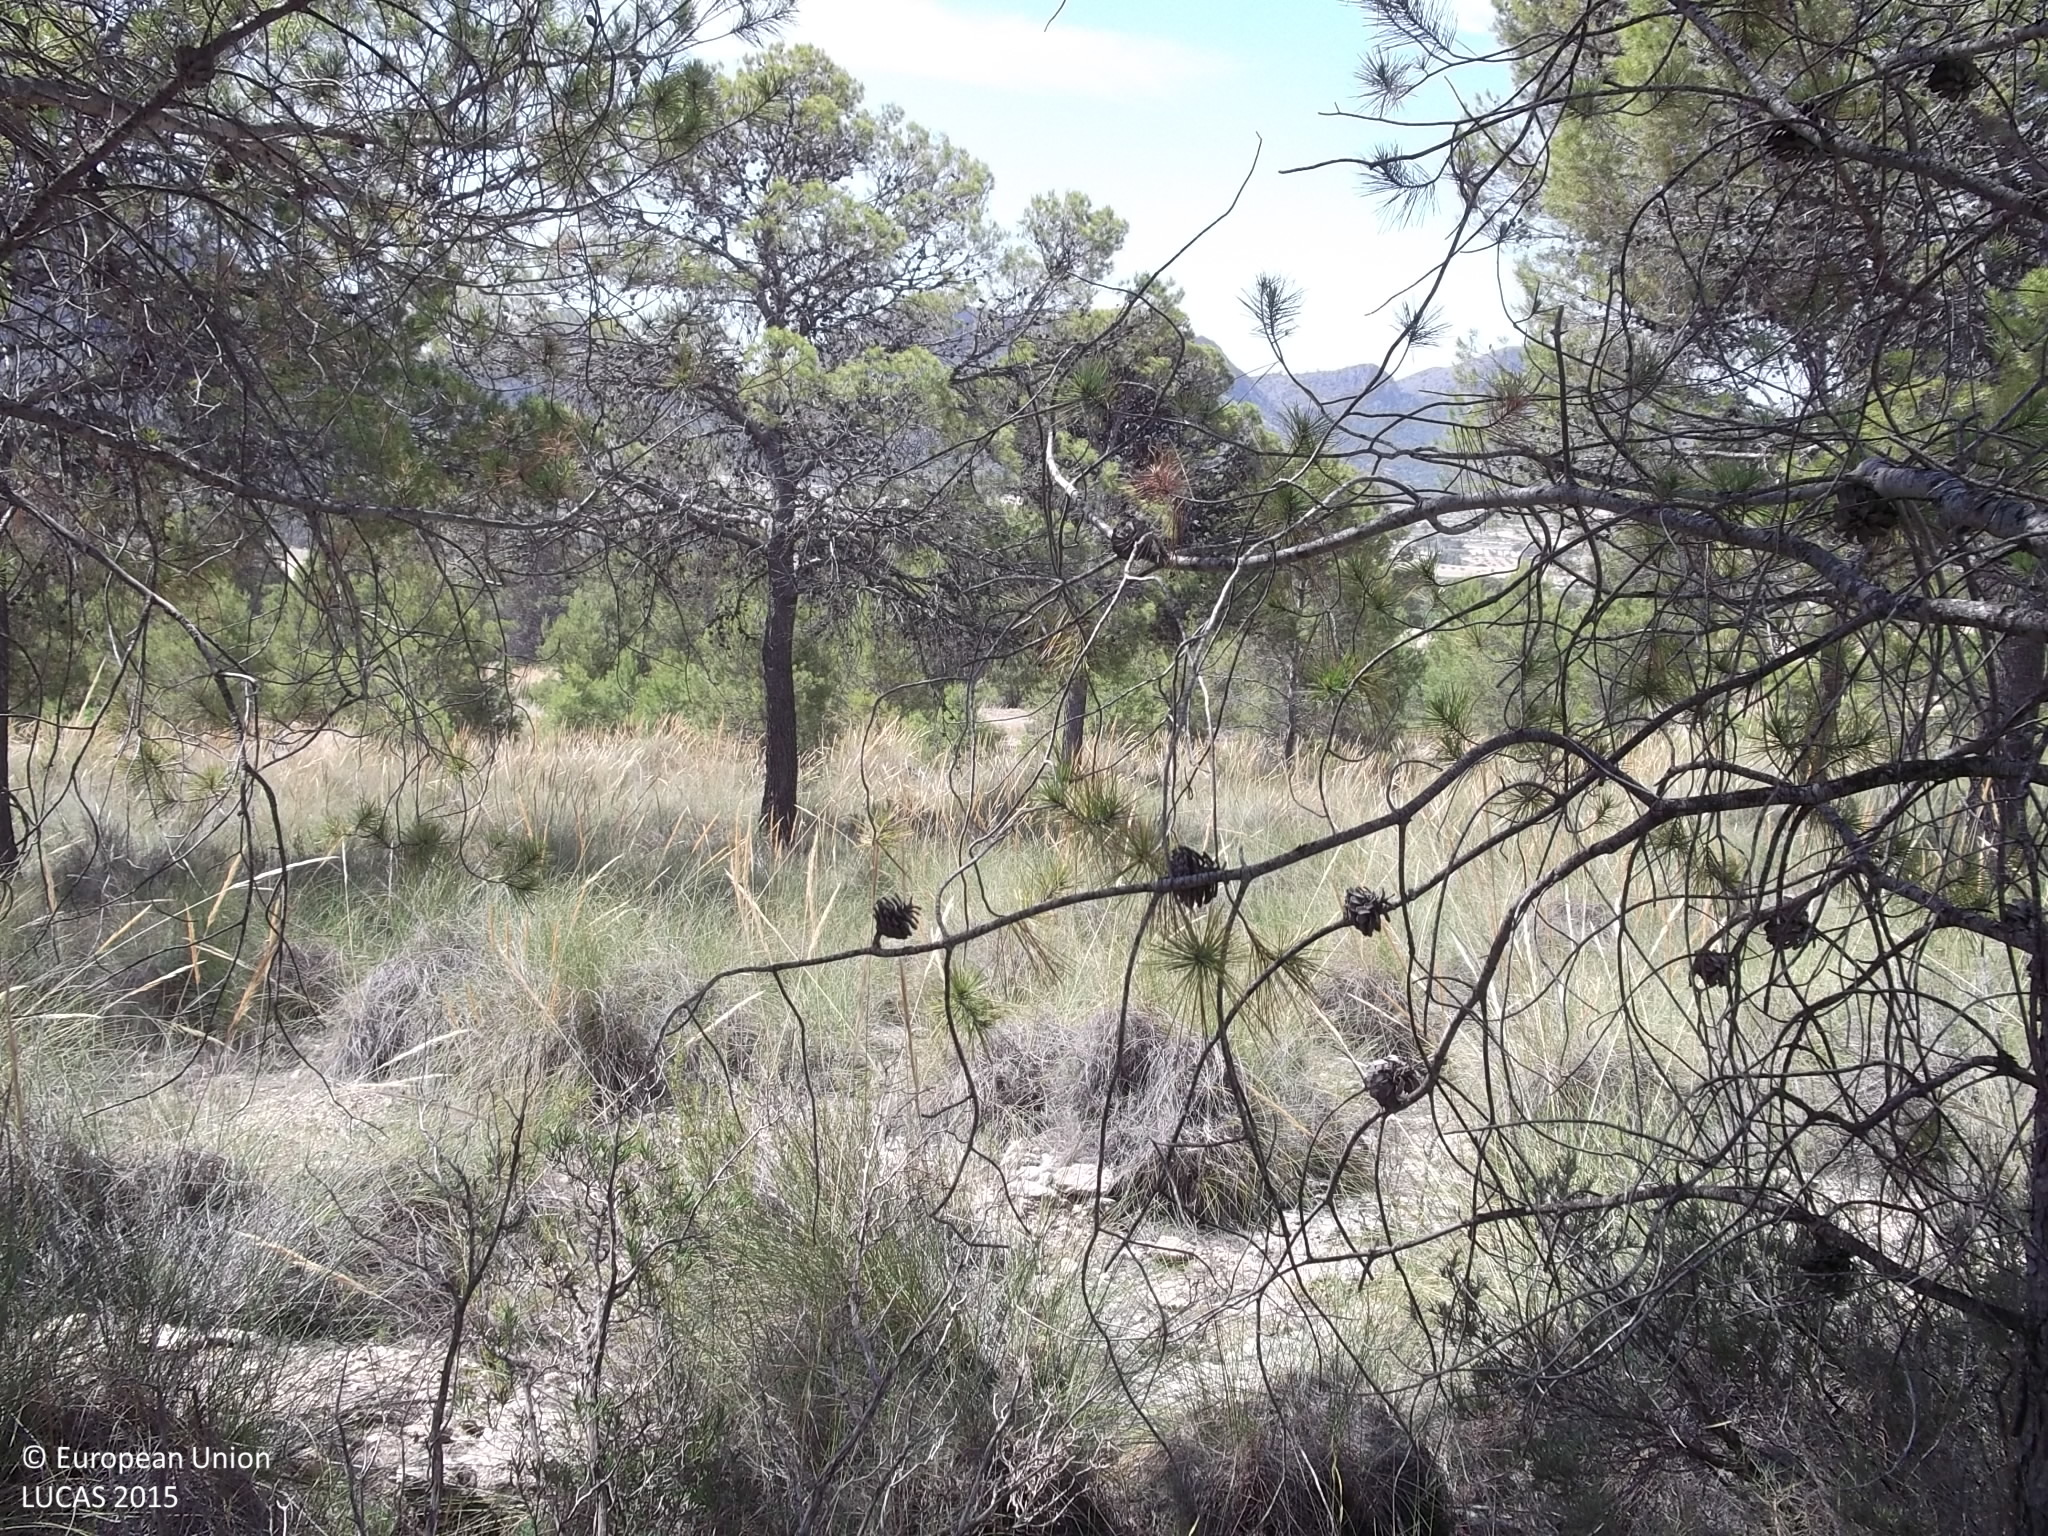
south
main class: Woodland
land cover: Pine dominated coniferous woodland
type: coniferous forest of the mediterranean region
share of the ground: 25 - 50 %
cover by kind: shrubs 35 %, coniferous forest trees 25 %, herbaceous plants 20 %, consolidated bare surface 20 %
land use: Semi-natural and natural areas not in use
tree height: > 5 m
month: June
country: ES
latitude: 38.4023
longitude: -1.3378
